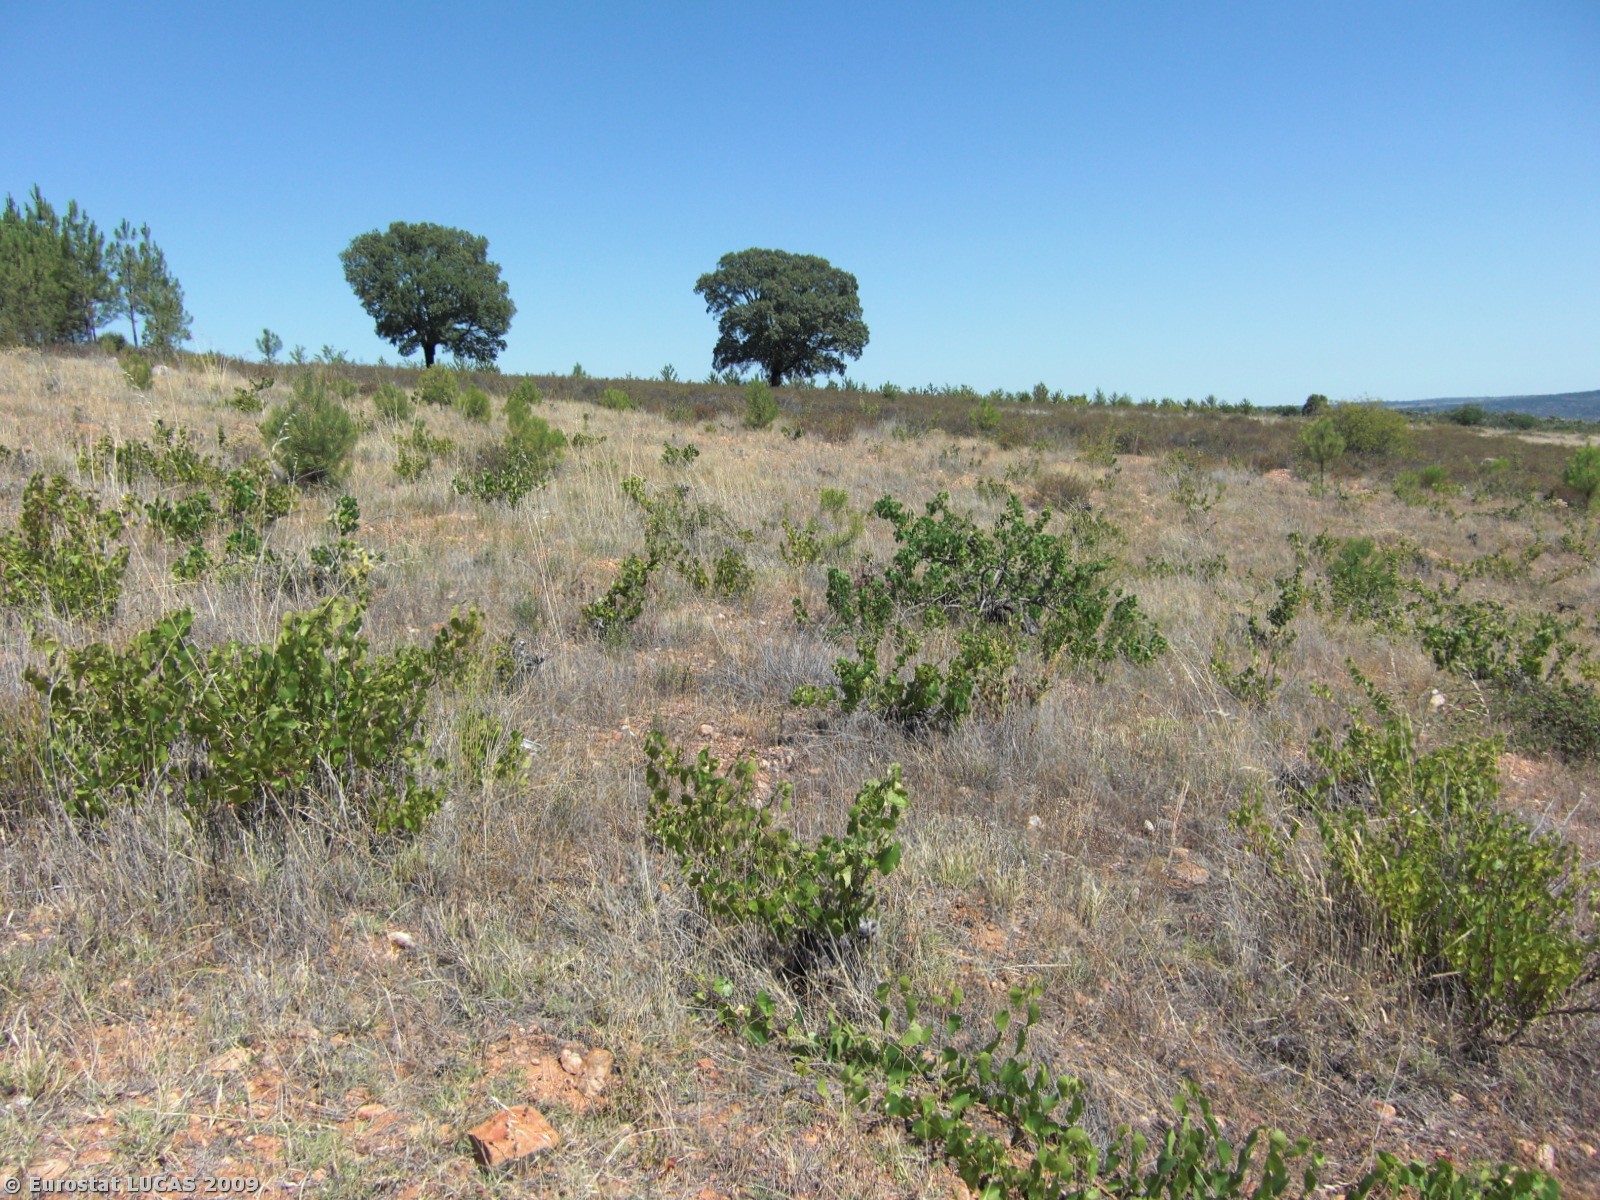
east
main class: Cropland
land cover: Vineyards
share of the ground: 10 - 25 %
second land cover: Spontaneously vegetated surfaces
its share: 50 - 75 %
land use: Agriculture (excluding fallow land and kitchen gardens)
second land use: Fallow land
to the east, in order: Vineyards; Spontaneously vegetated surfaces; Vineyards; Ditches and canals; Shrubland with sparse tree cover; Tracks; Shrubland with sparse tree cover; Broadleaved woodland; Spontaneously vegetated surfaces; Bare land; Shruby margins; Tracks
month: August
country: PT
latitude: 41.3983
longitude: -6.4015
